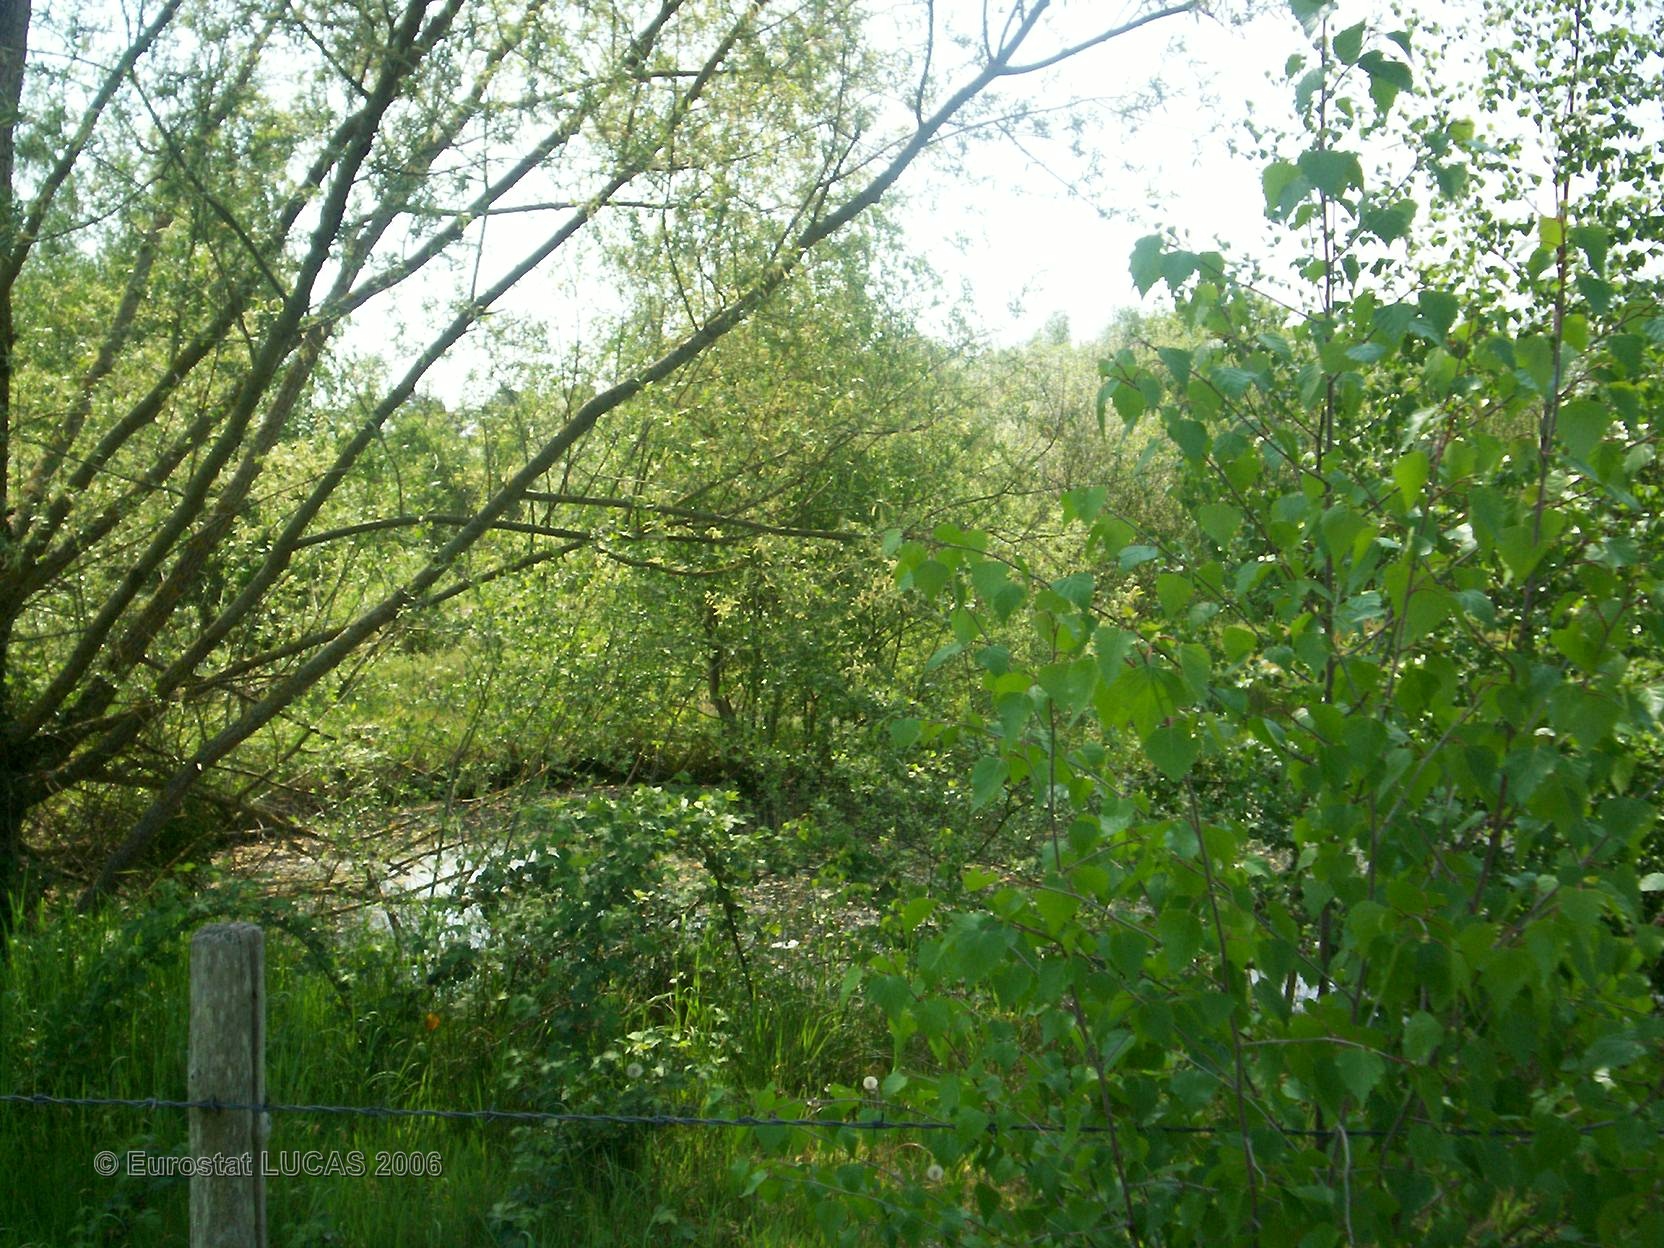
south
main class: Grassland
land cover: Grassland without tree/shrub cover
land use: Agriculture (excluding fallow land and kitchen gardens)
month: May
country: FR
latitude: 47.7673
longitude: 0.1945
